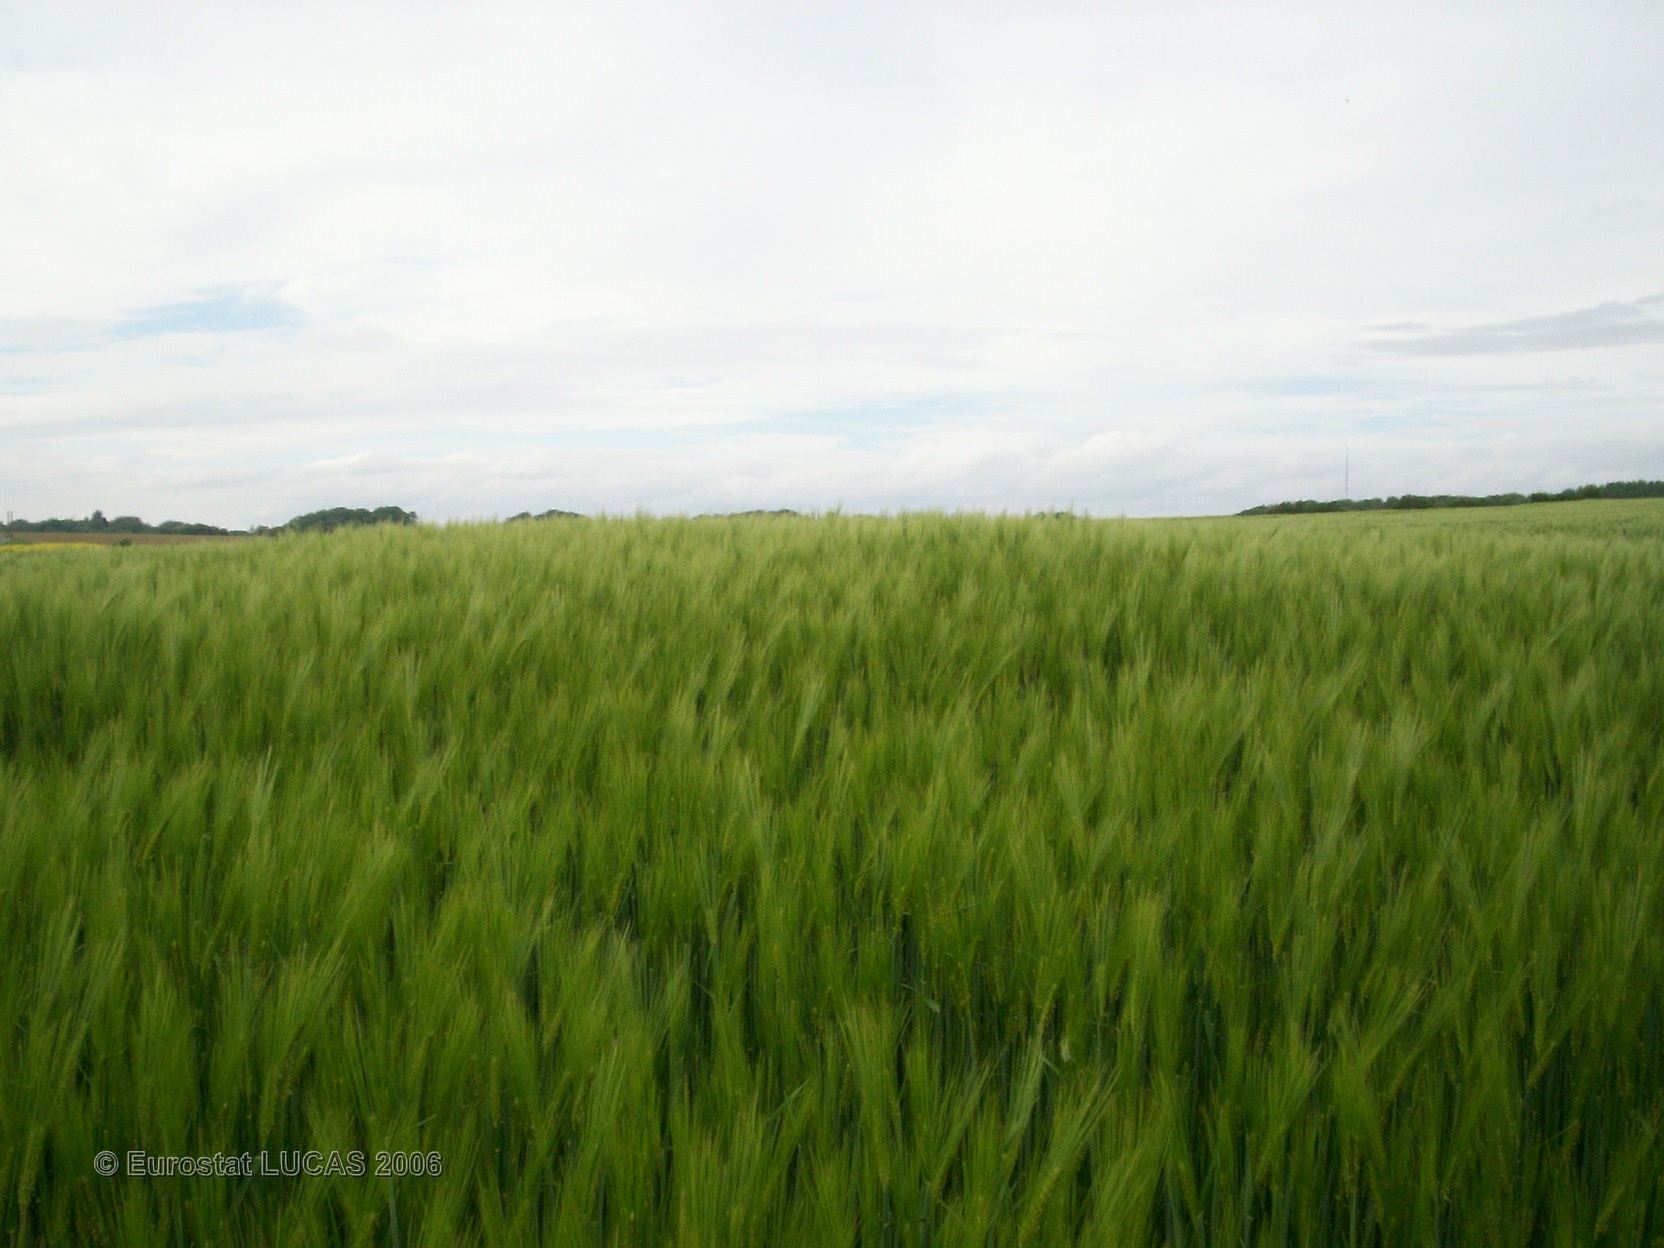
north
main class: Cropland
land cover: Barley
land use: Agriculture (excluding fallow land and kitchen gardens)
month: May
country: FR
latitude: 50.3792
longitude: 2.6335
